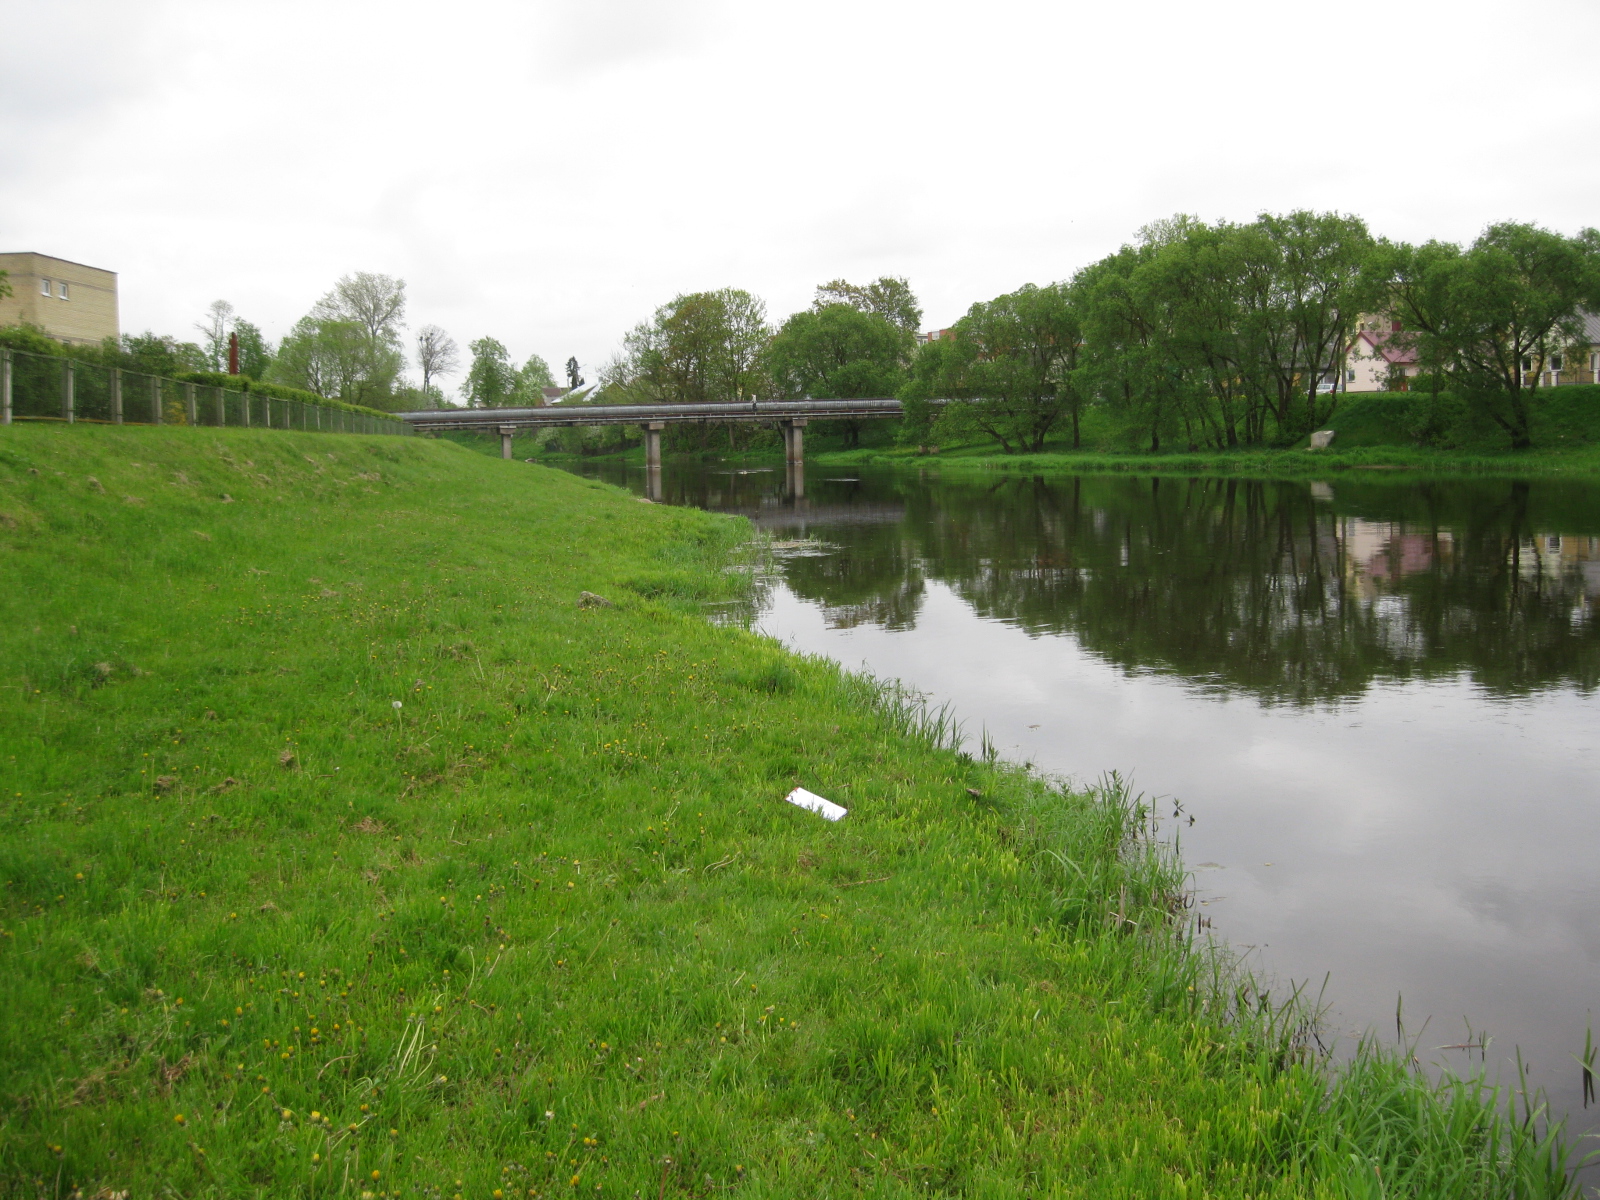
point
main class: Grassland
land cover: Grassland without tree/shrub cover
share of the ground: > 75 %
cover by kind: herbaceous plants 100 %
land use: Amenities, museums, leisure
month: May
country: LT
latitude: 56.0642
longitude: 24.4065
